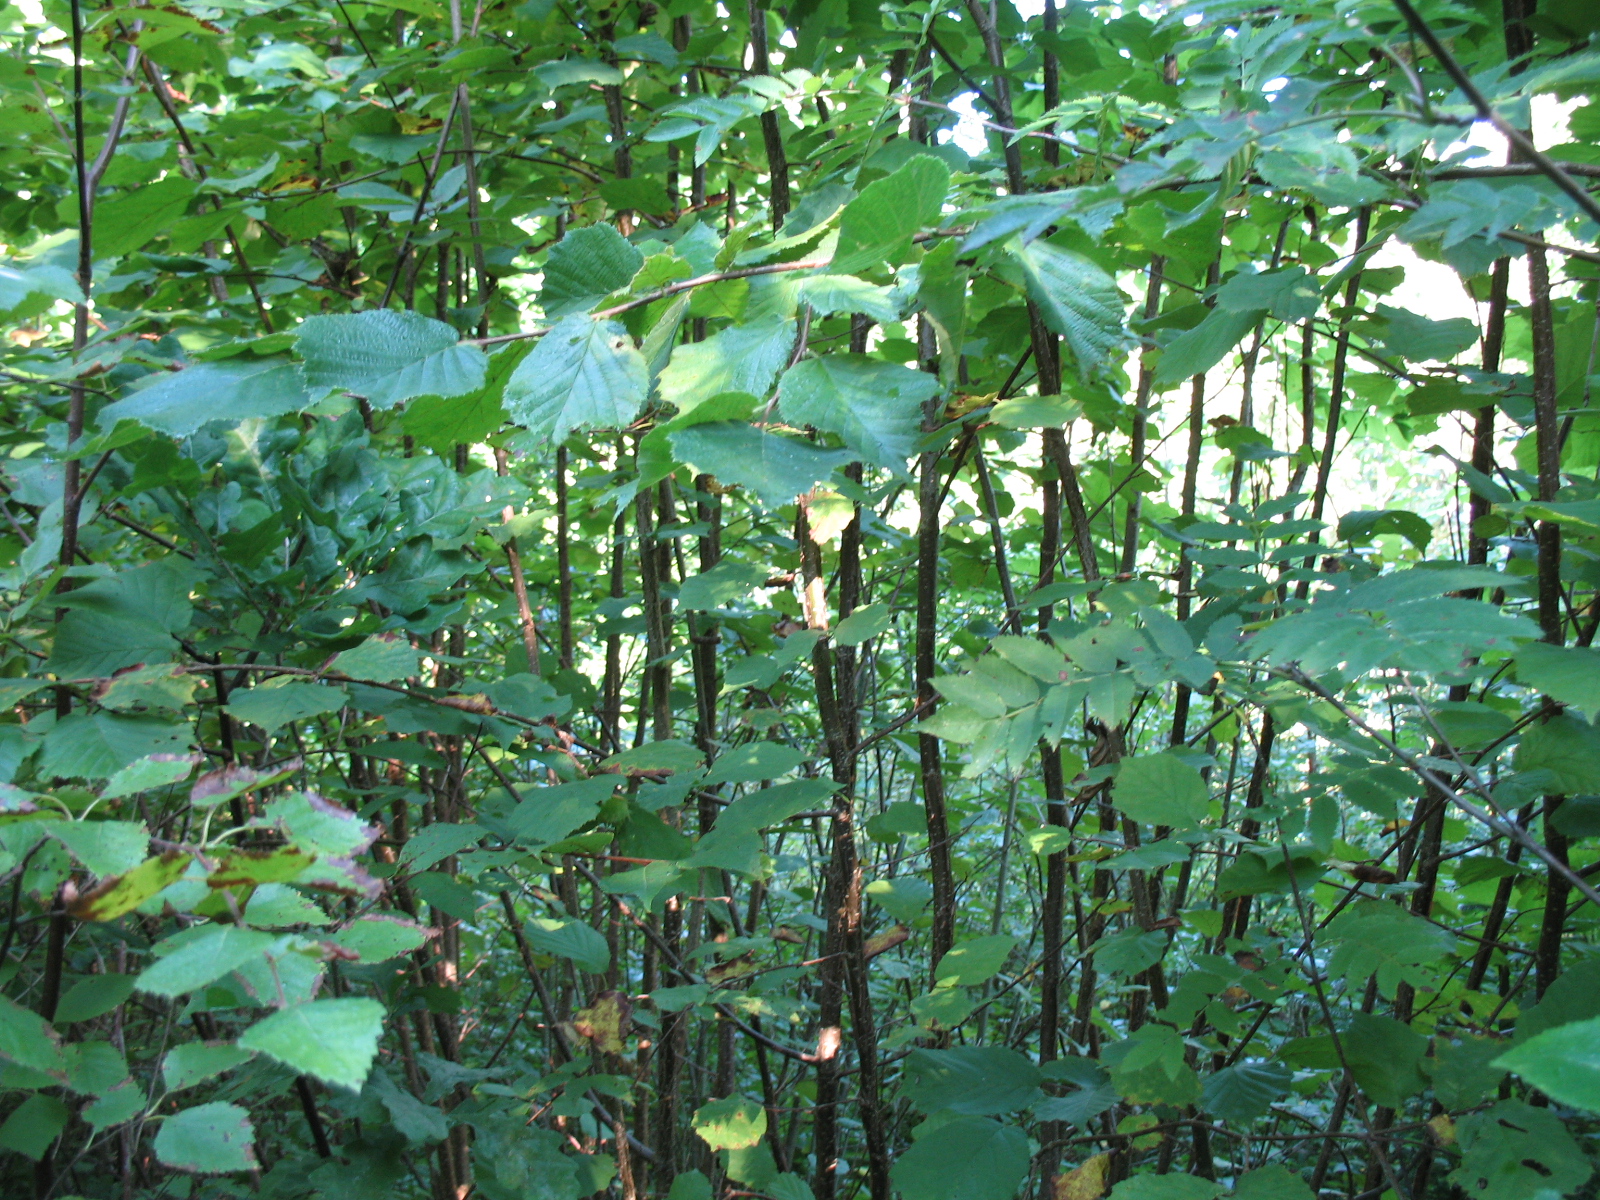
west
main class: Woodland
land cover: Broadleaved woodland
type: non-riverine alder, birch or aspen forest
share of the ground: > 75 %
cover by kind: broadleaved forest trees 90 %, shrubs 5 %, herbaceous plants 5 %
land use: Forestry
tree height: > 5 m
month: August
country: LV
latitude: 56.6061
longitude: 25.7157
